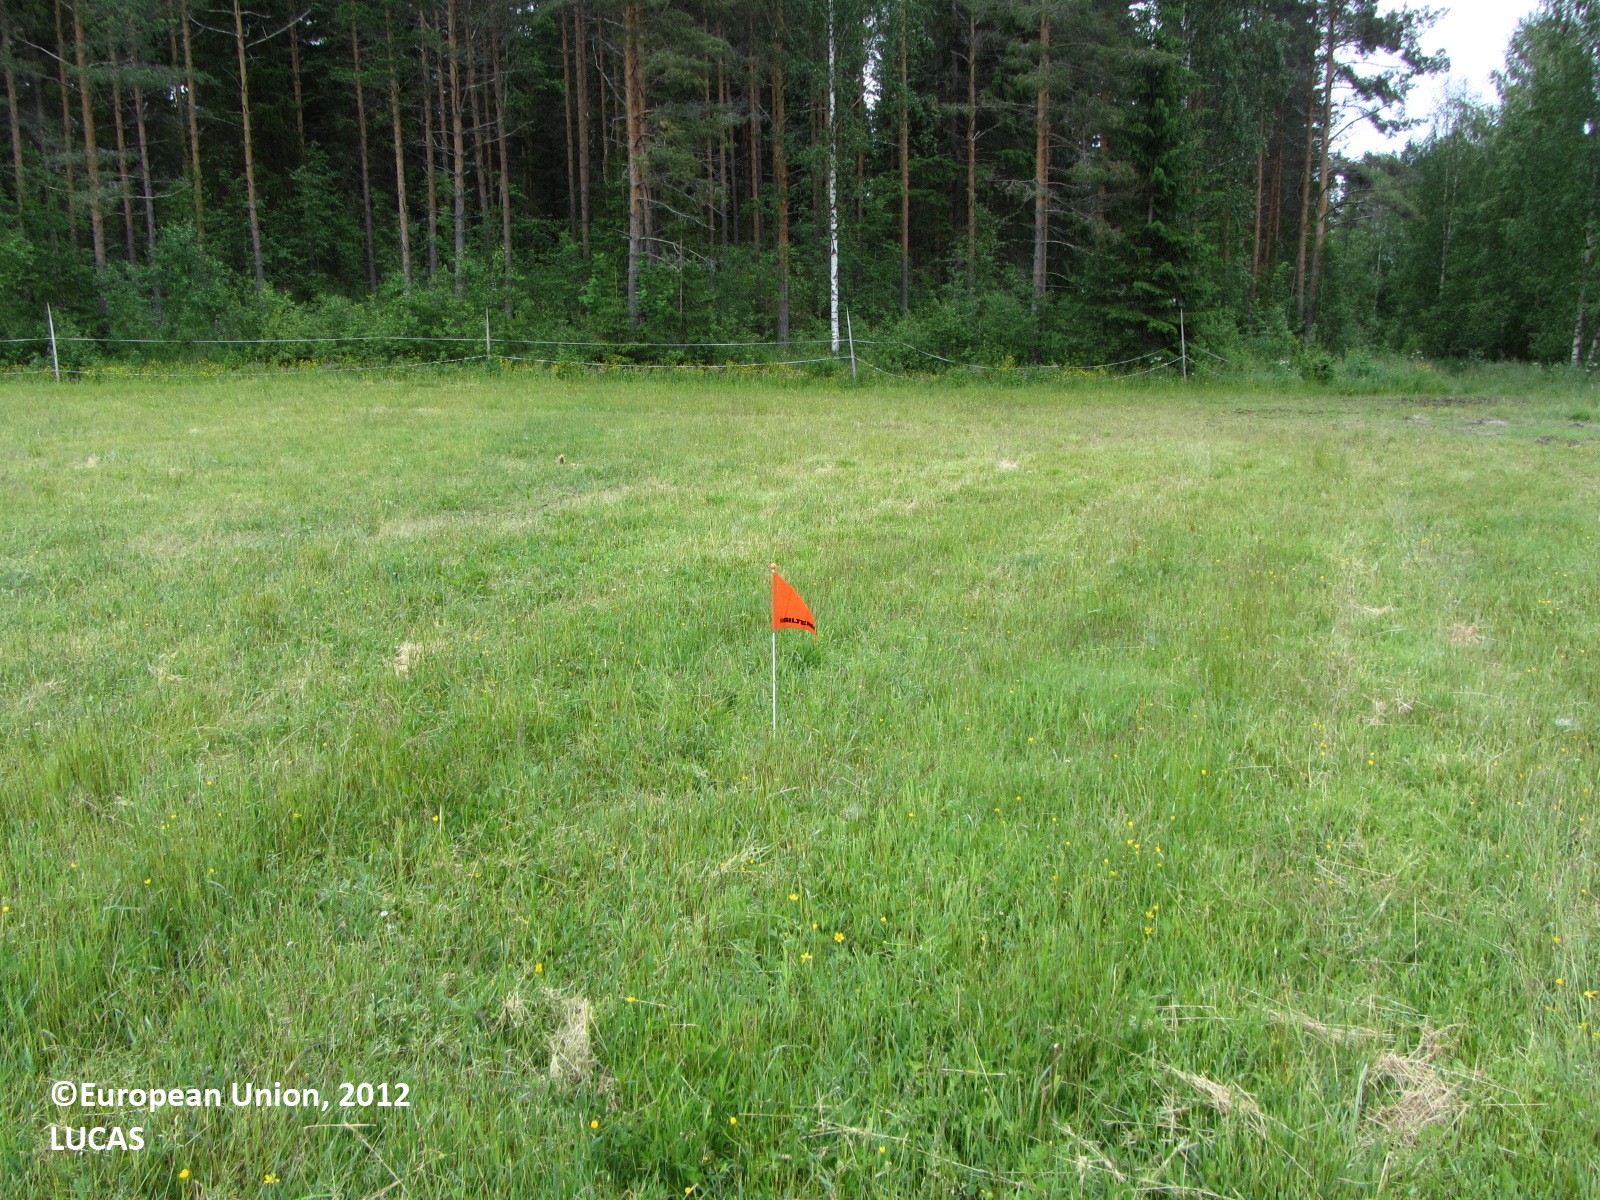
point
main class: Grassland
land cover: Grassland without tree/shrub cover
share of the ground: > 75 %
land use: Agriculture (excluding fallow land and kitchen gardens)
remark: Harvested field
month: June
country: FI
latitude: 62.6565
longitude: 25.2678
